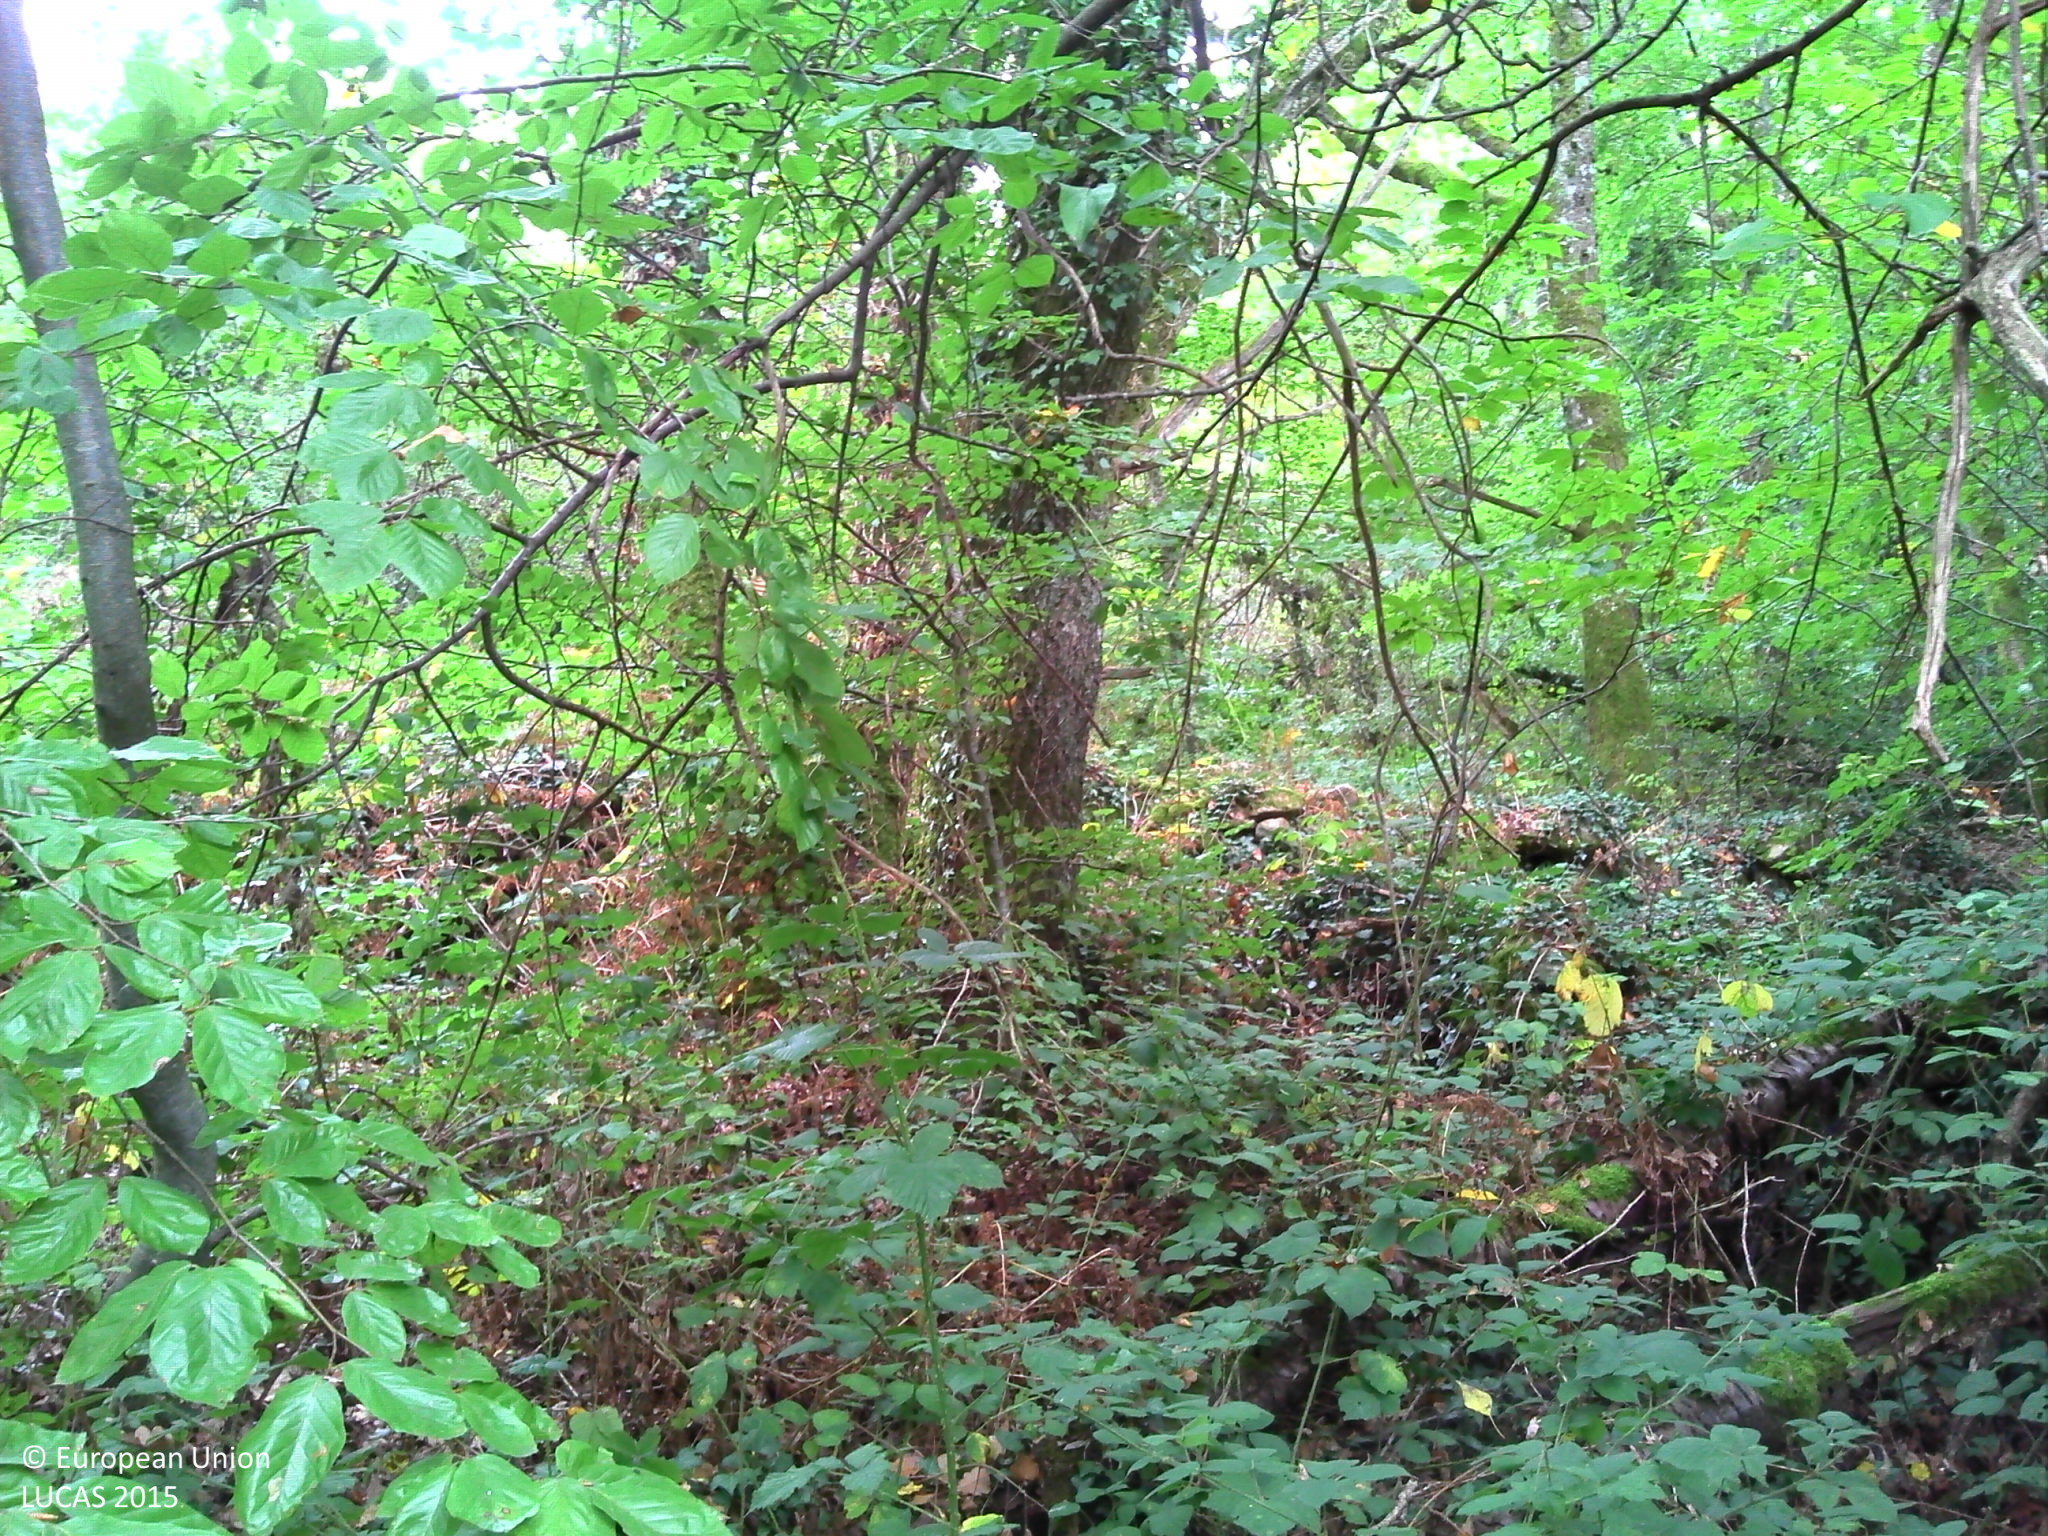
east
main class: Woodland
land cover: Broadleaved woodland
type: beech forest
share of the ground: > 75 %
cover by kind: broadleaved forest trees 90 %, herbaceous plants 10 %
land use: Forestry
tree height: > 5 m
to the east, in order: Broadleaved woodland; Dry stone walls; Broadleaved woodland; Dry stone walls; Broadleaved woodland; Dry stone walls; Fences; Grass margins; Tracks; Grass margins; Fences; Broadleaved woodland
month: September
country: FR
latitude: 46.2188
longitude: 2.8285
